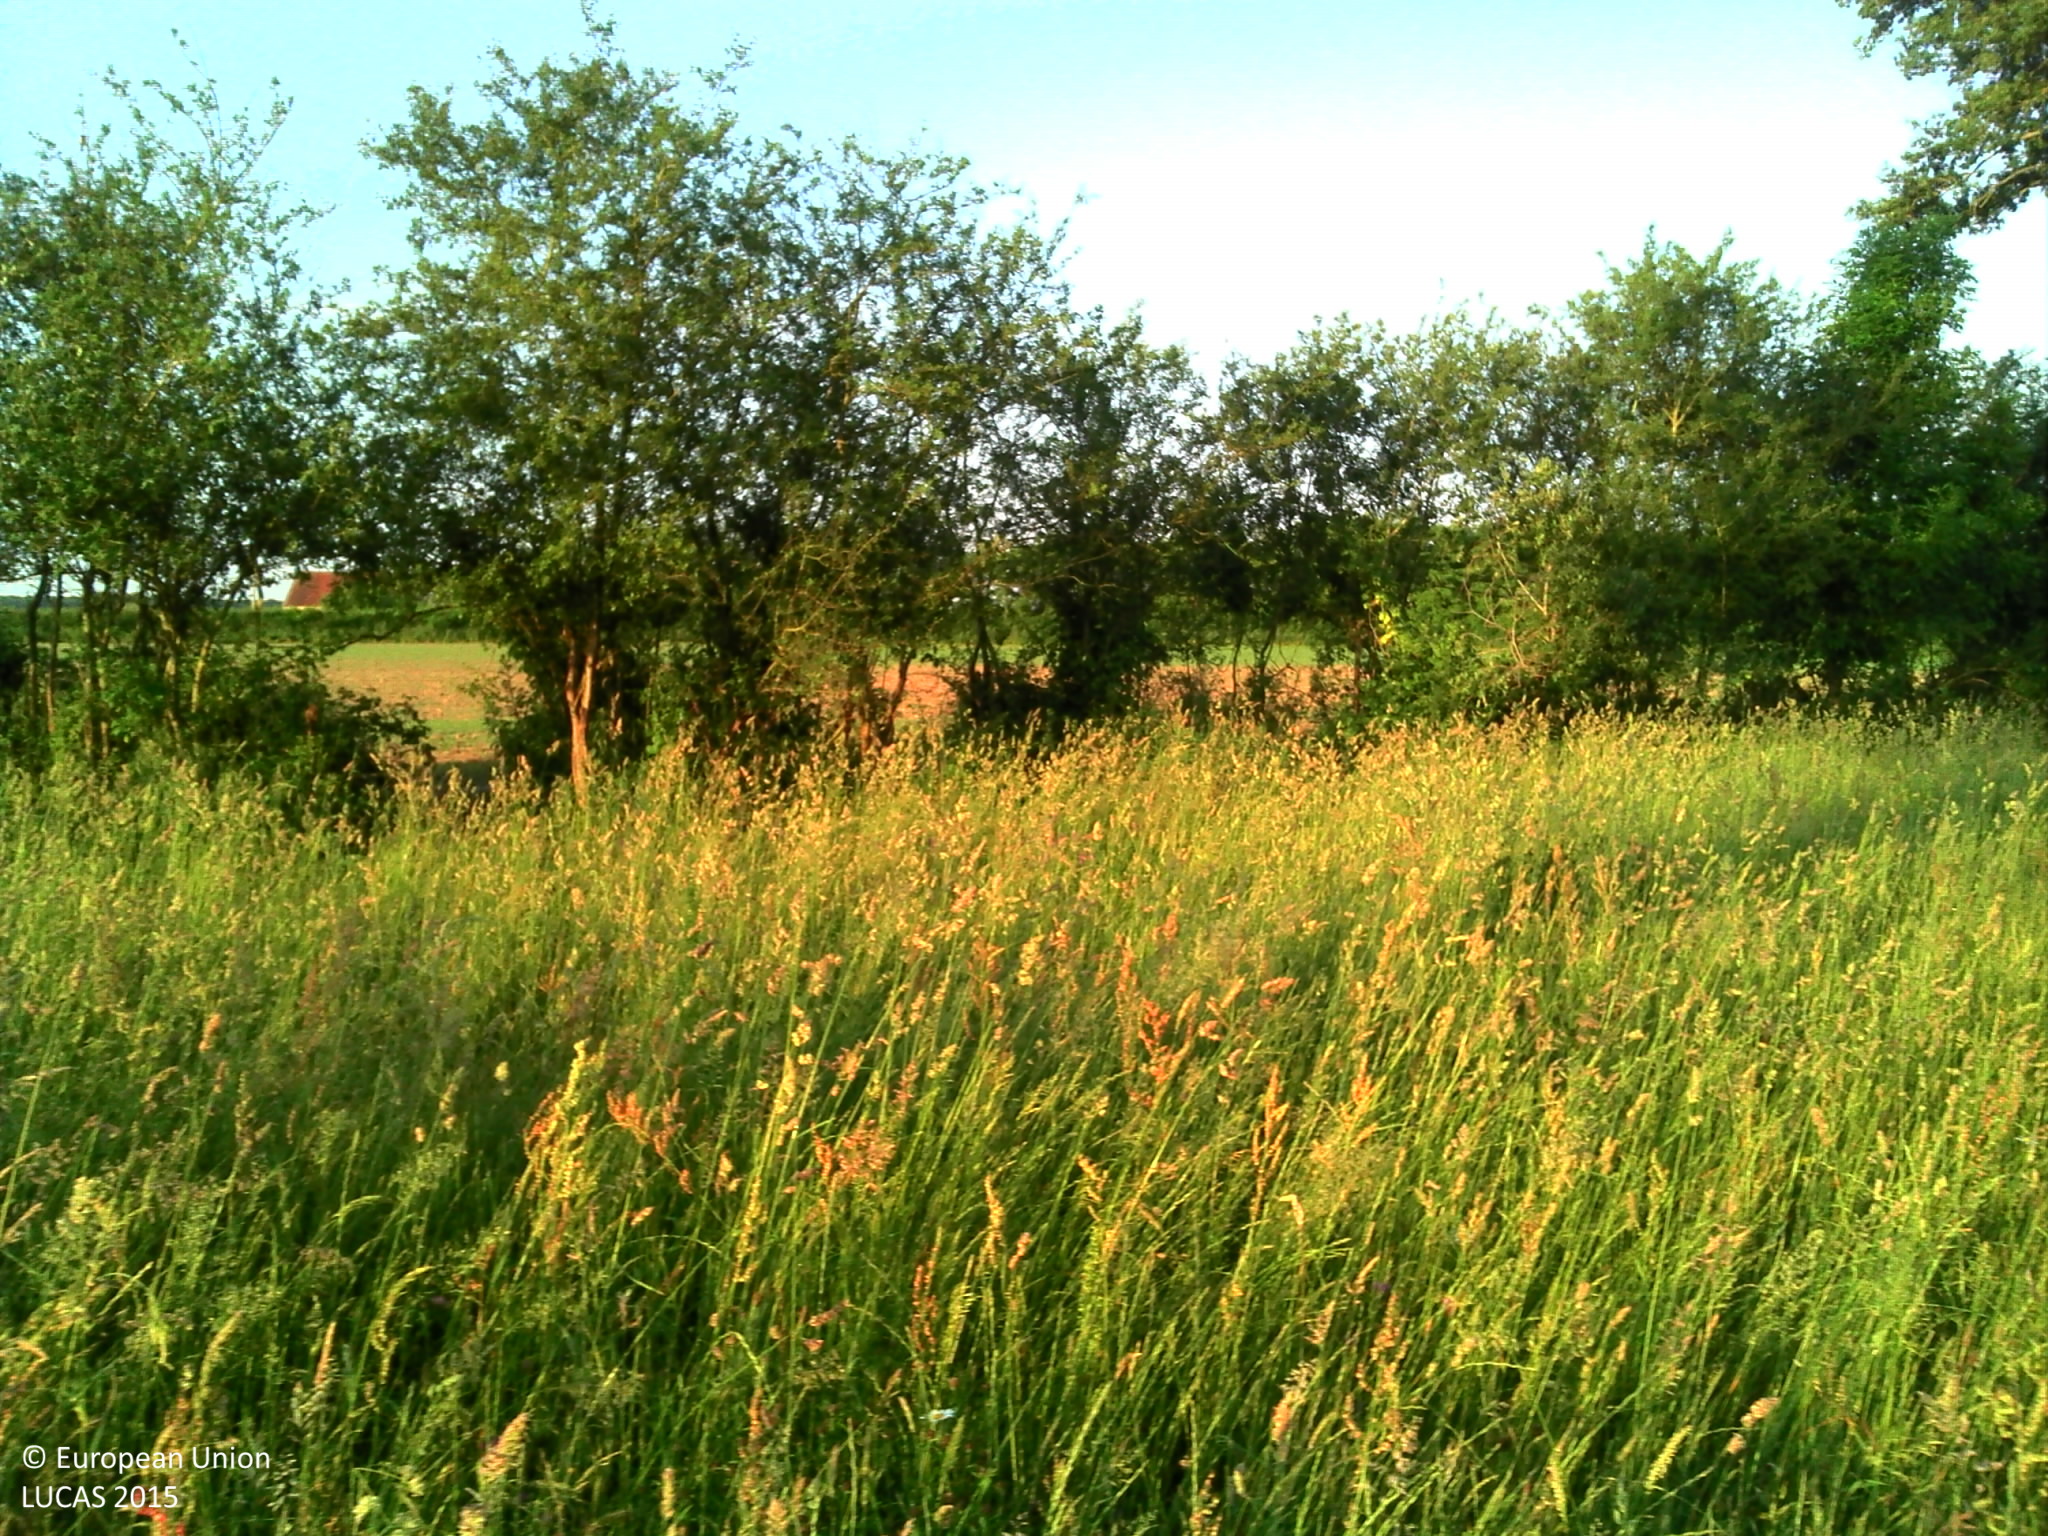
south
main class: Grassland
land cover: Grassland without tree/shrub cover
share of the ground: > 75 %
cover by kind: herbaceous plants 100 %
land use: Agriculture (excluding fallow land and kitchen gardens)
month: June
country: FR
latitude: 46.8042
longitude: 2.9332
